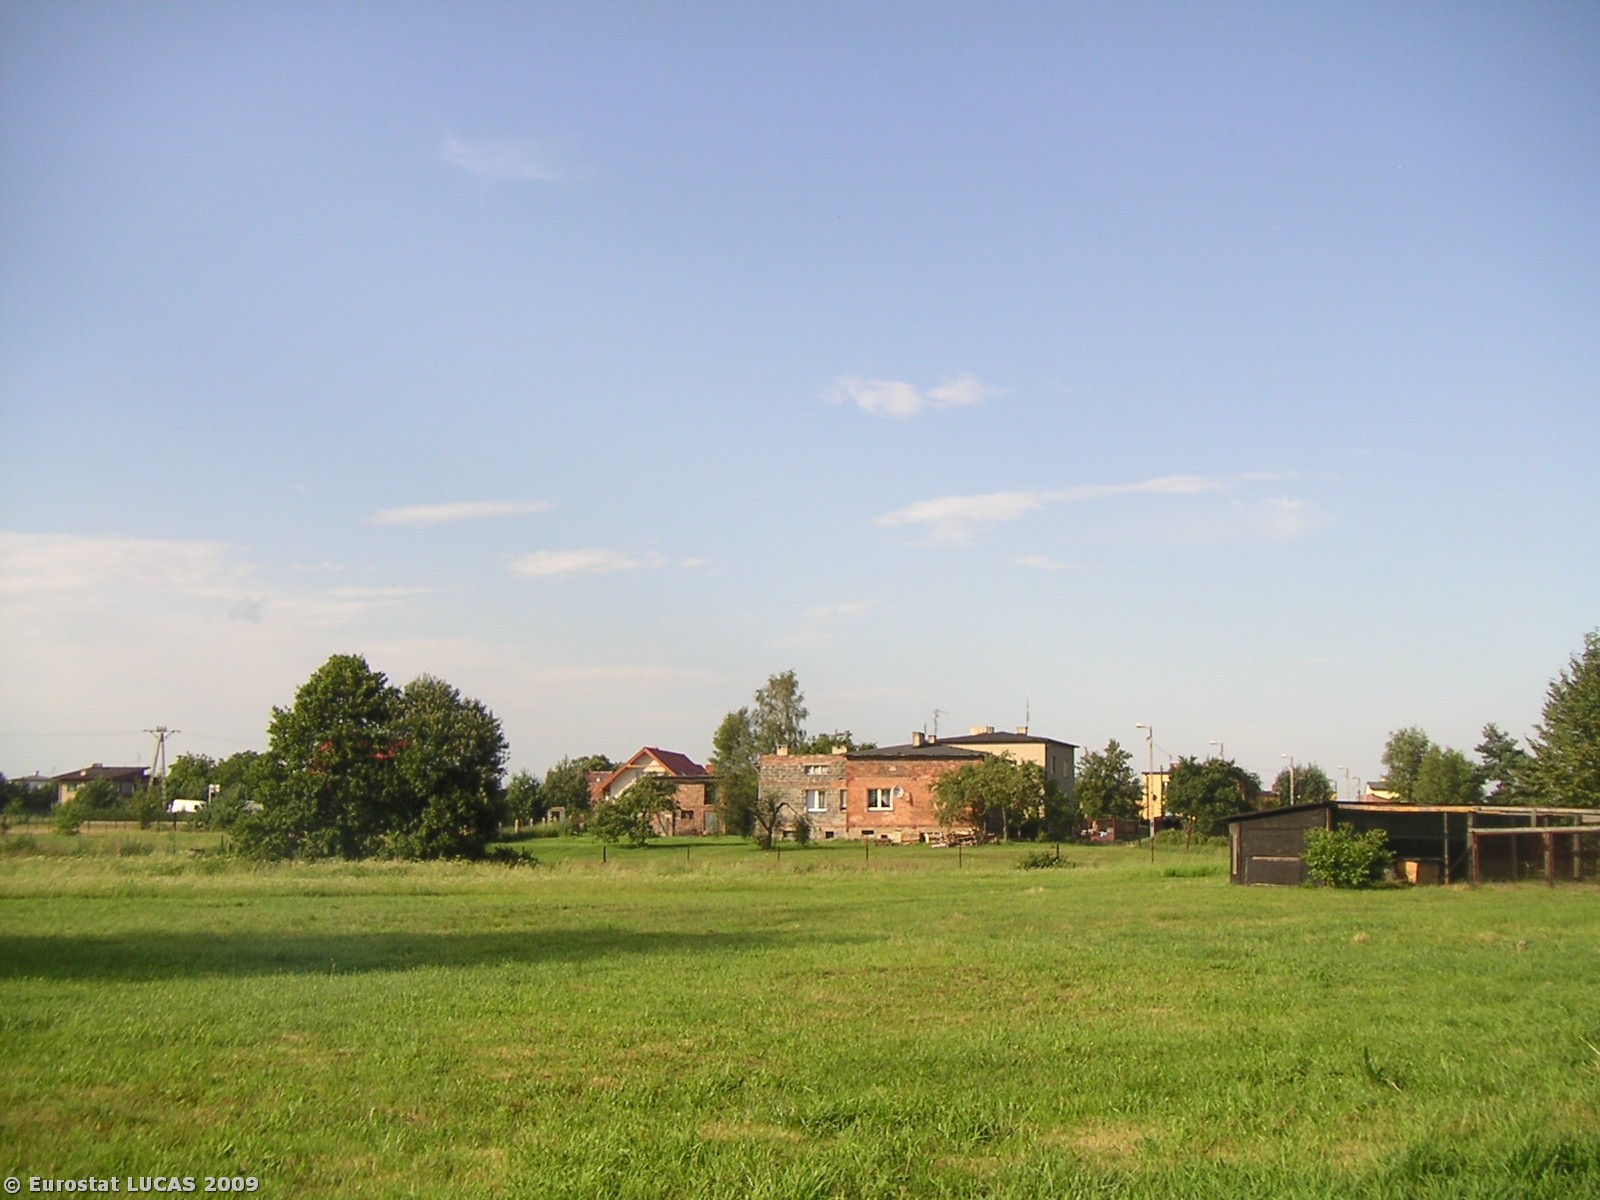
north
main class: Grassland
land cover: Grassland without tree/shrub cover
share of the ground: > 75 %
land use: Agriculture (excluding fallow land and kitchen gardens)
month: July
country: PL
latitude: 50.2226
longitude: 18.8096
